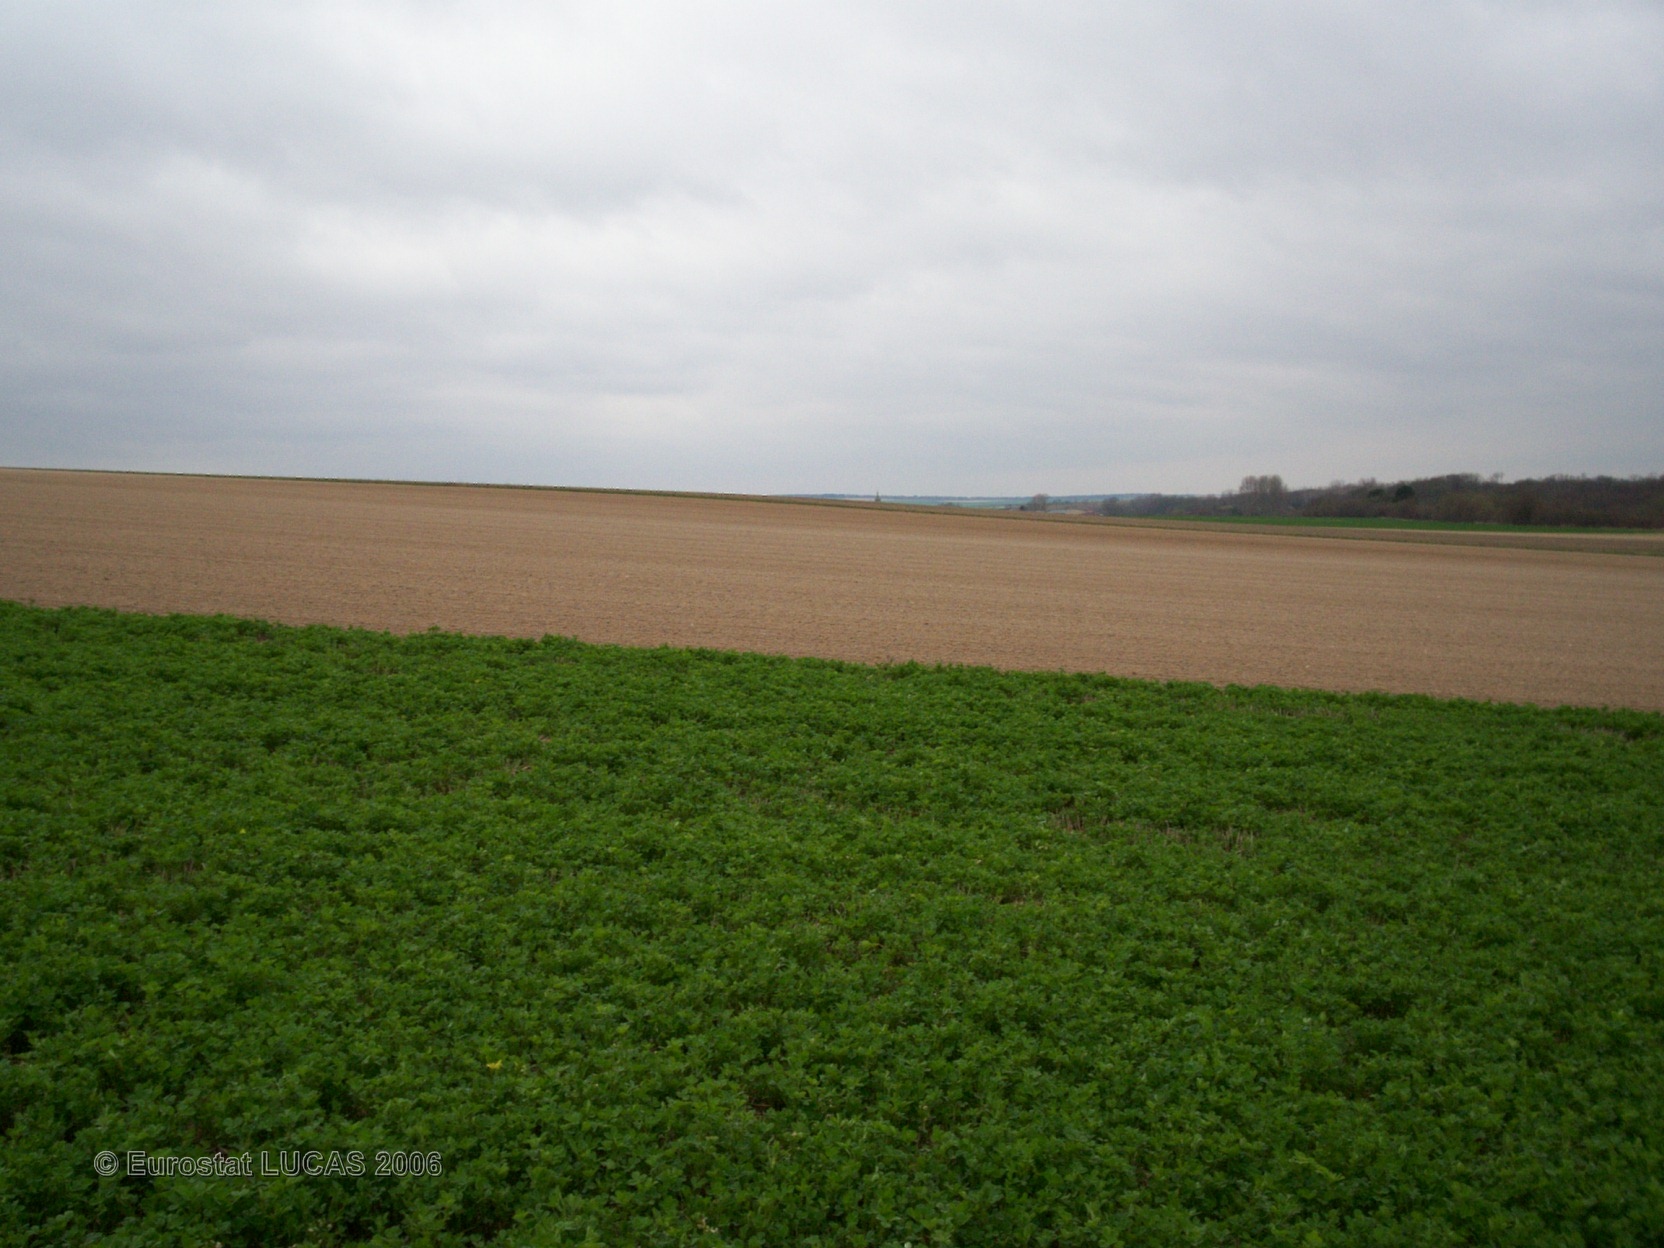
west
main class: Cropland
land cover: Lucerne
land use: Agriculture (excluding fallow land and kitchen gardens)
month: April
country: FR
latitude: 49.2371
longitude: 4.4339
